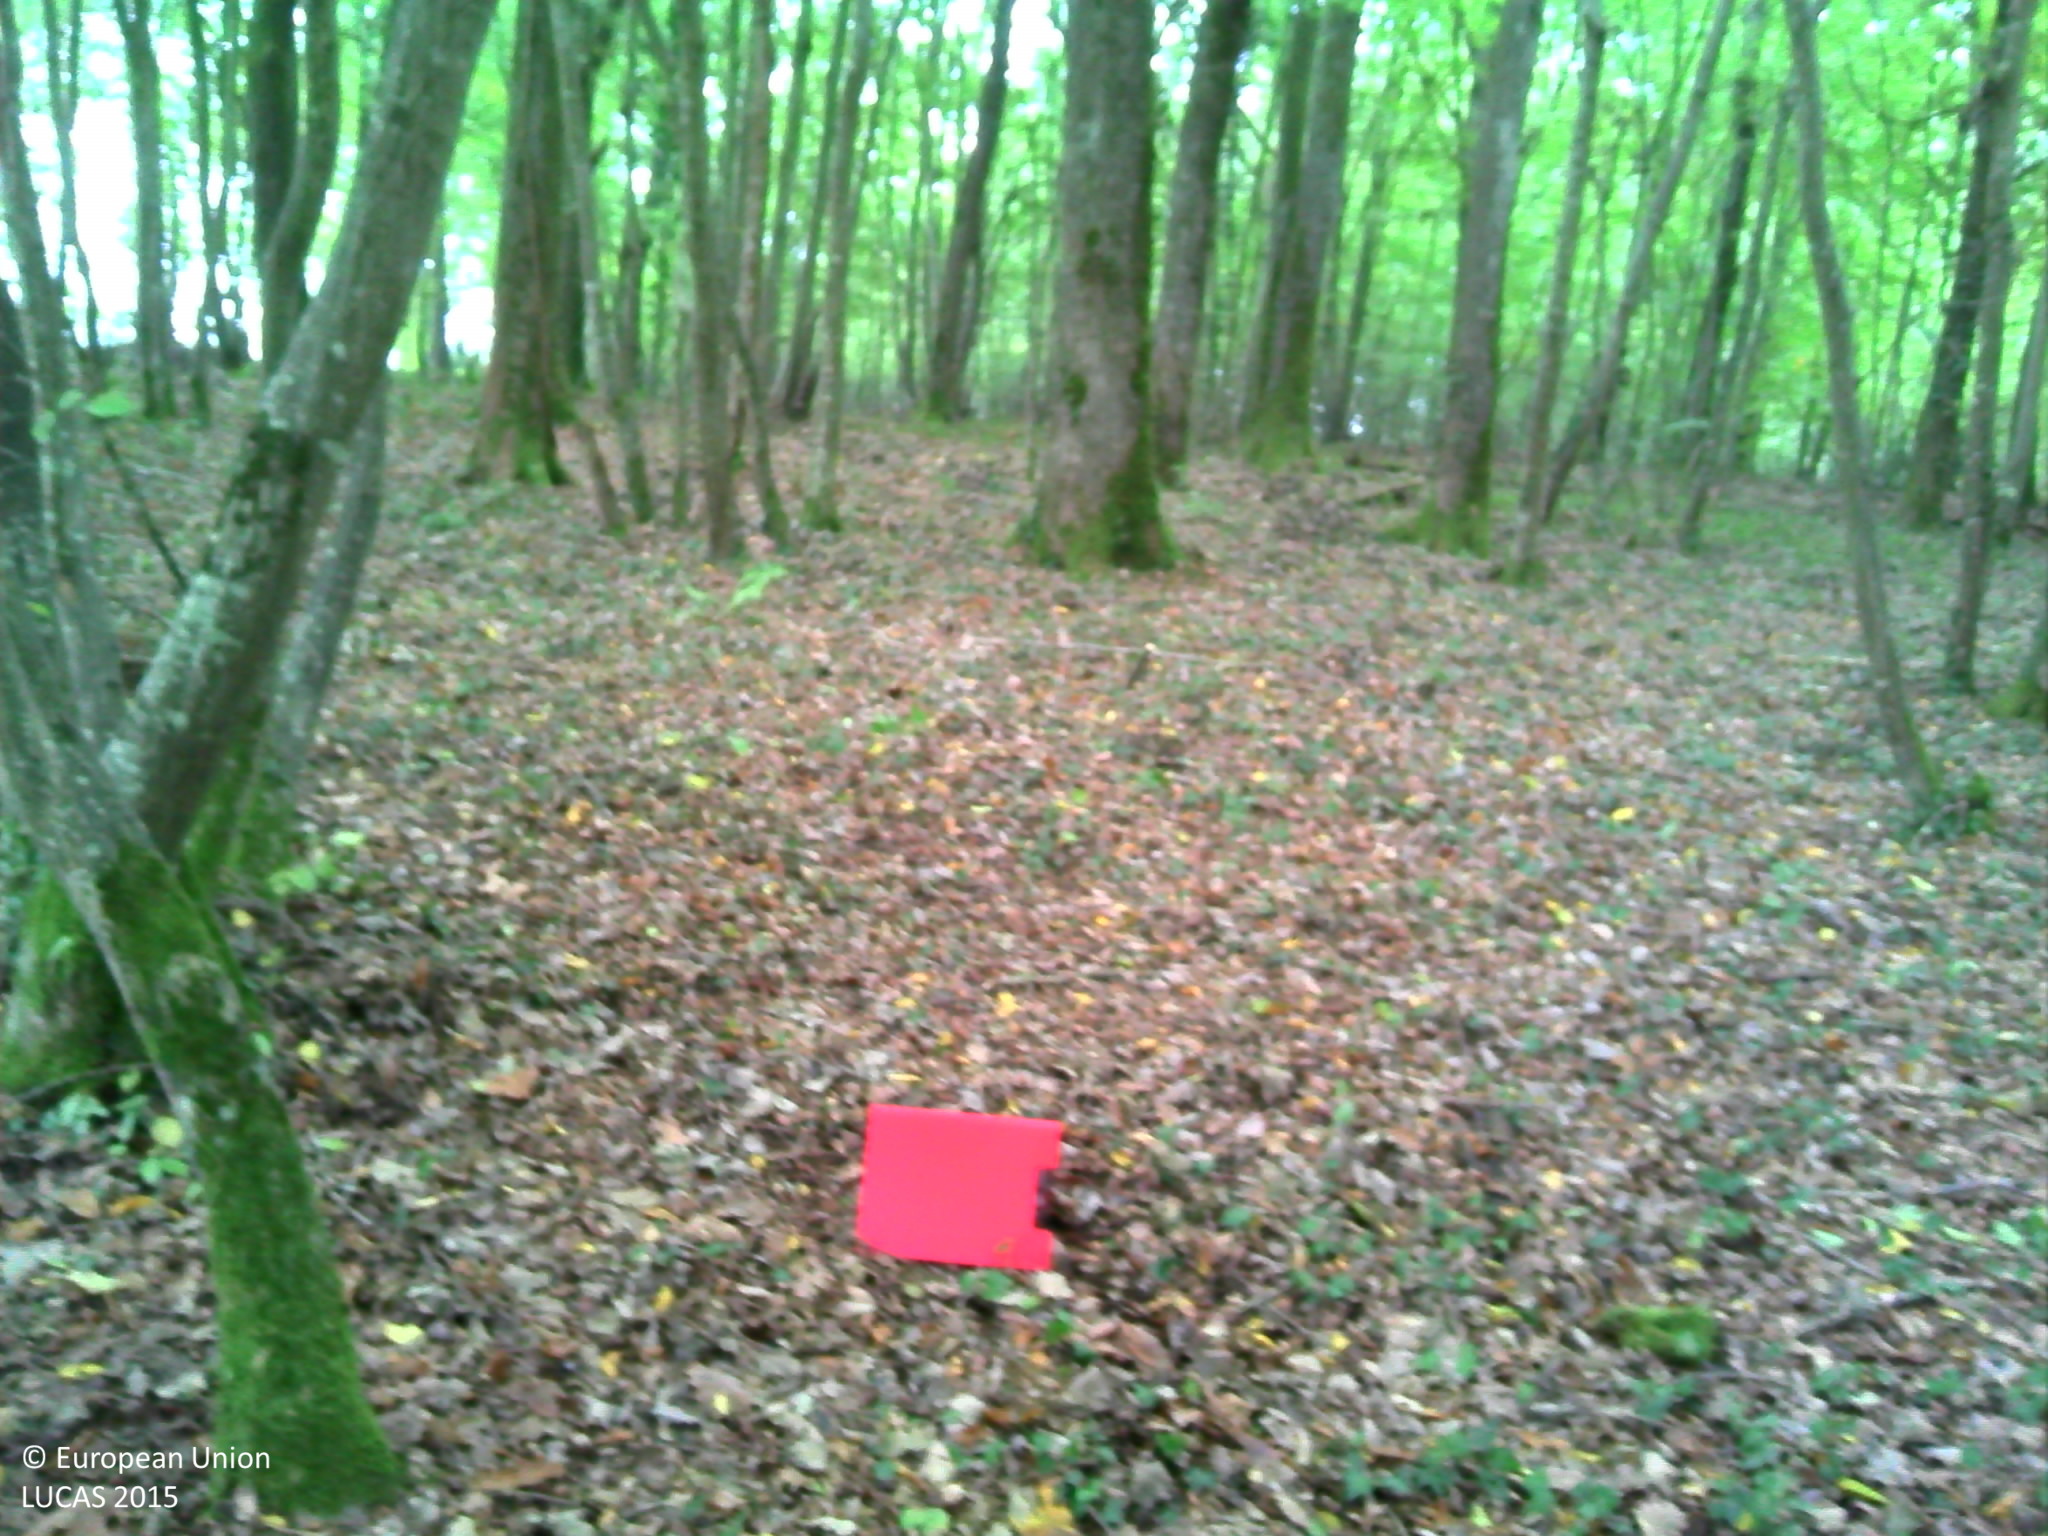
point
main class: Woodland
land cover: Broadleaved woodland
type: mesophytic deciduous forest
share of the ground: > 75 %
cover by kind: broadleaved forest trees 95 %, herbaceous plants 5 %
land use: Forestry
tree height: > 5 m
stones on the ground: < 10 %
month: October
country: FR
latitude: 46.2587
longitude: 5.1379
